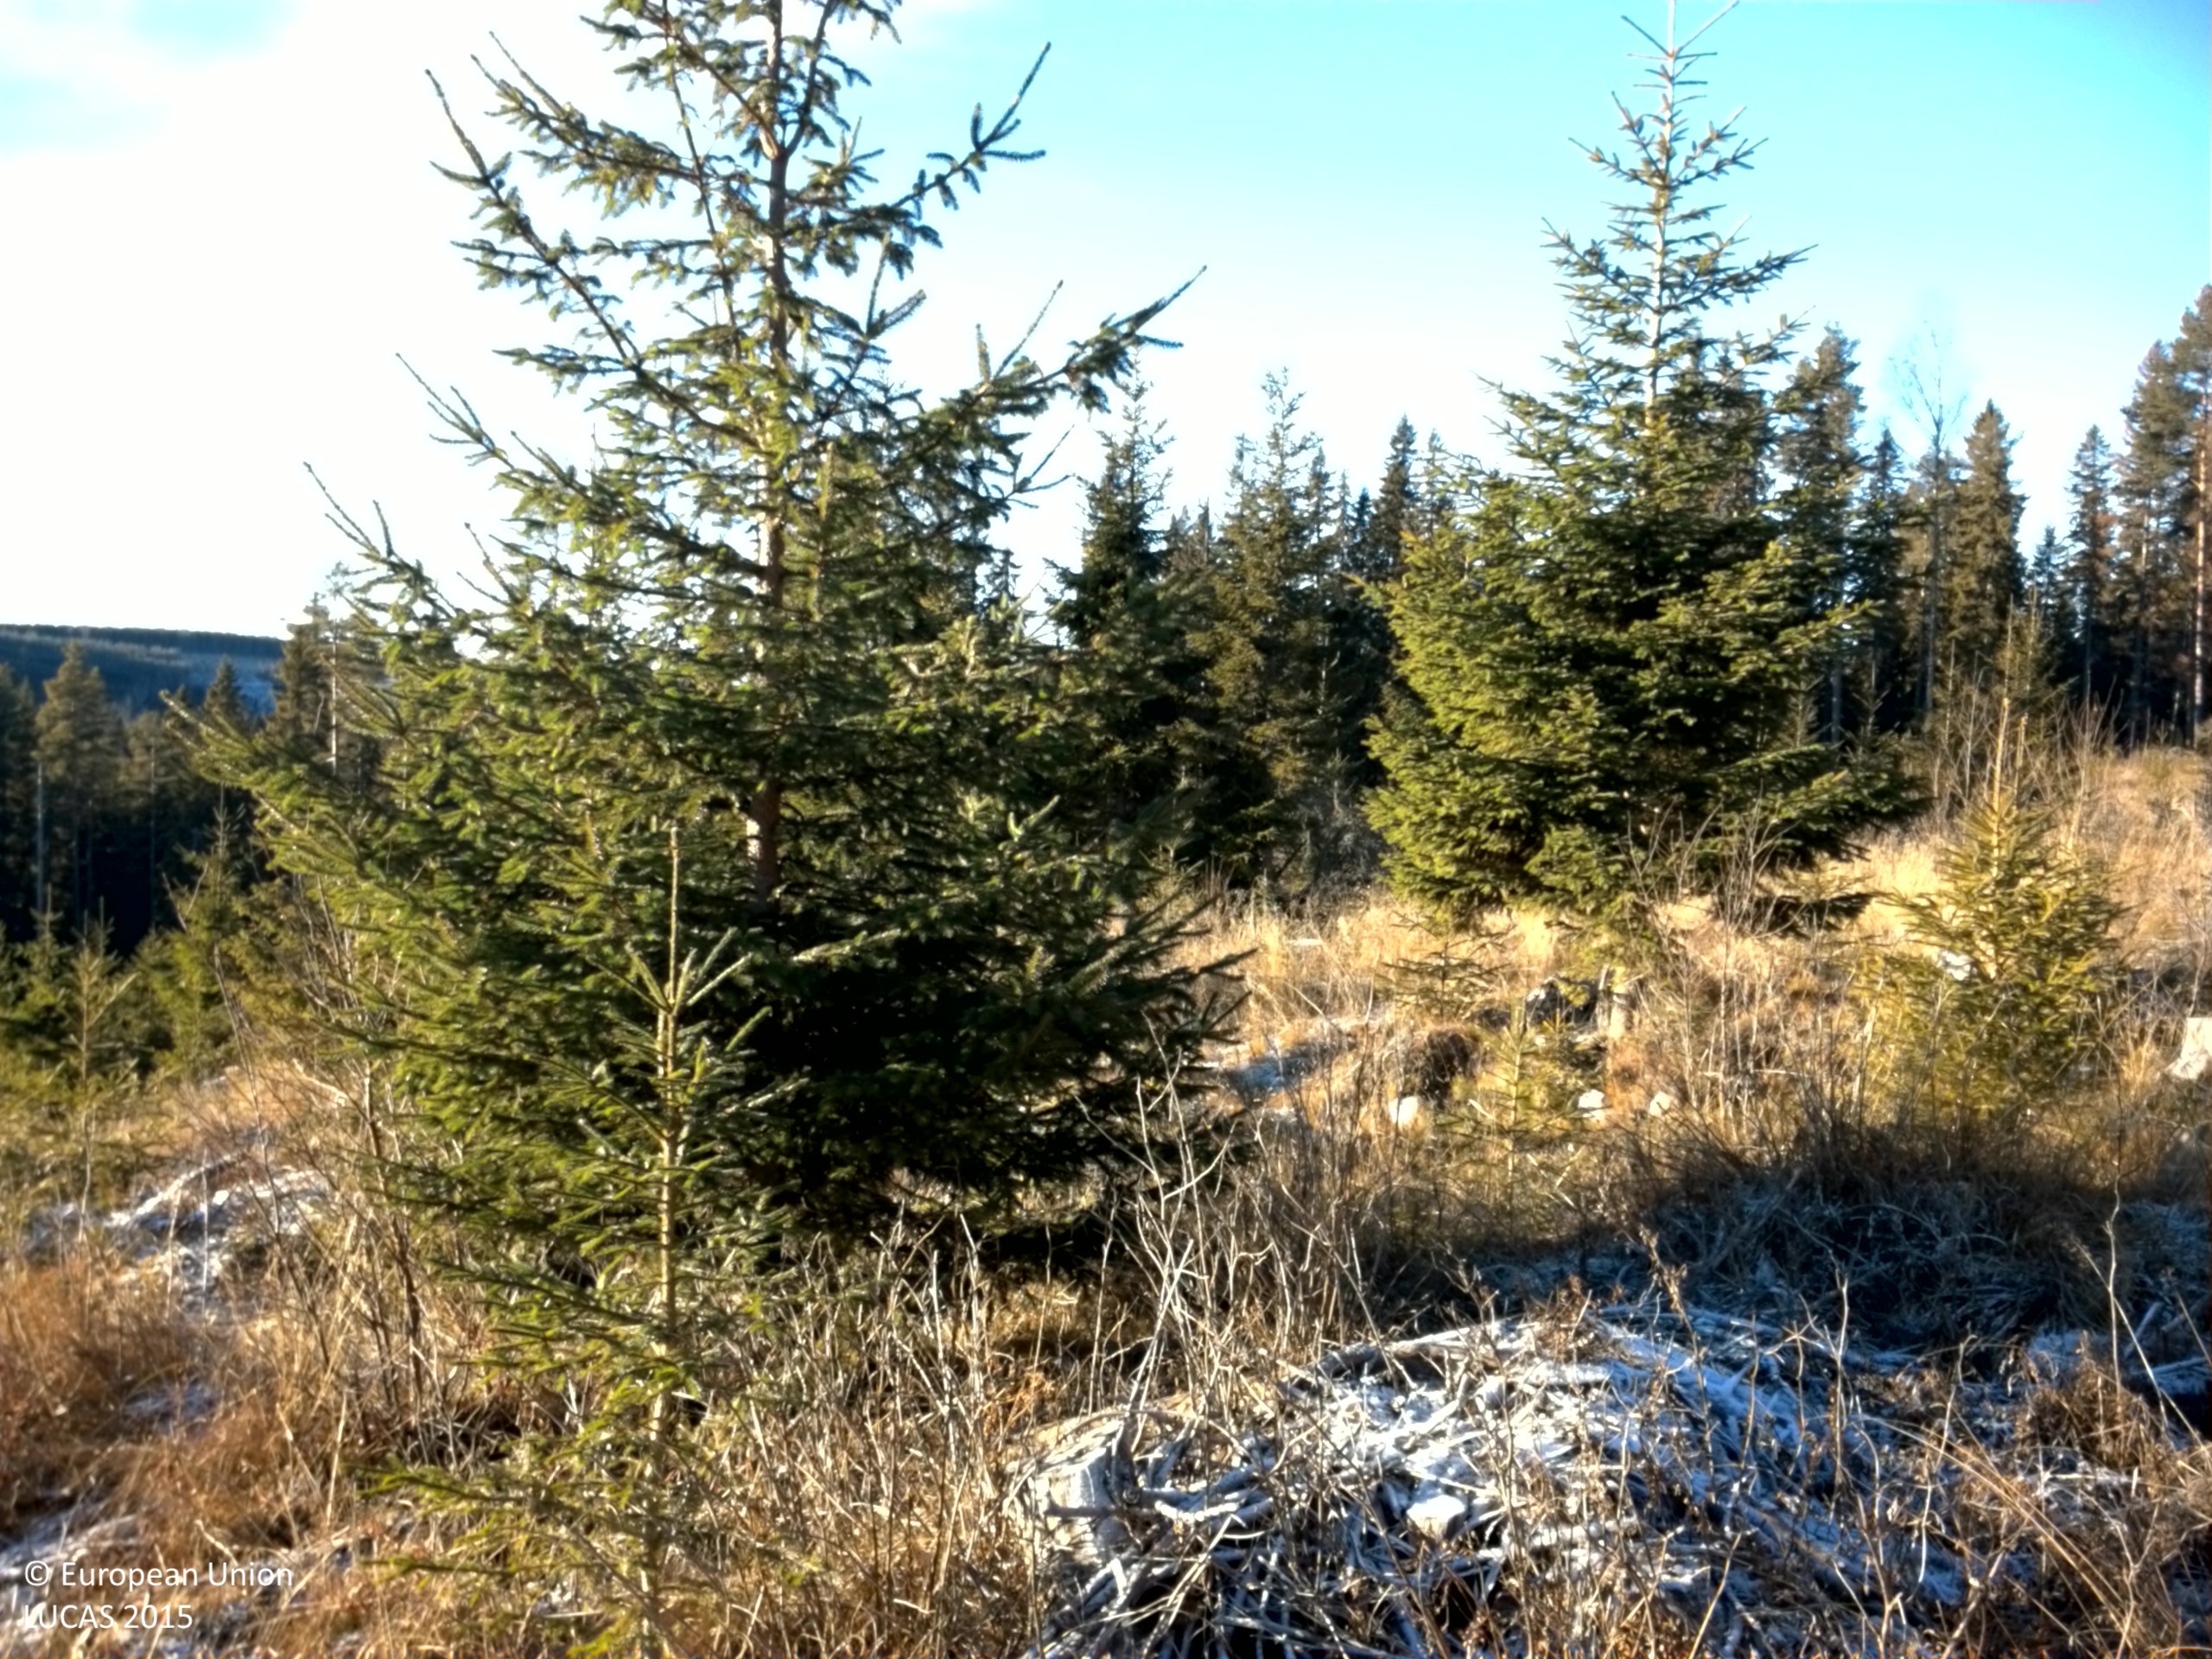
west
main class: Woodland
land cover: Spruce dominated mixed woodland
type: boreal forest
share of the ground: 25 - 50 %
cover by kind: herbaceous plants 50 %, coniferous forest trees 25 %, broadleaved forest trees 10 %, lichens and mosses 10 %, shrubs 5 %
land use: Forestry
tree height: < 5 m
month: November
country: SE
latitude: 61.8877
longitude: 16.2029
